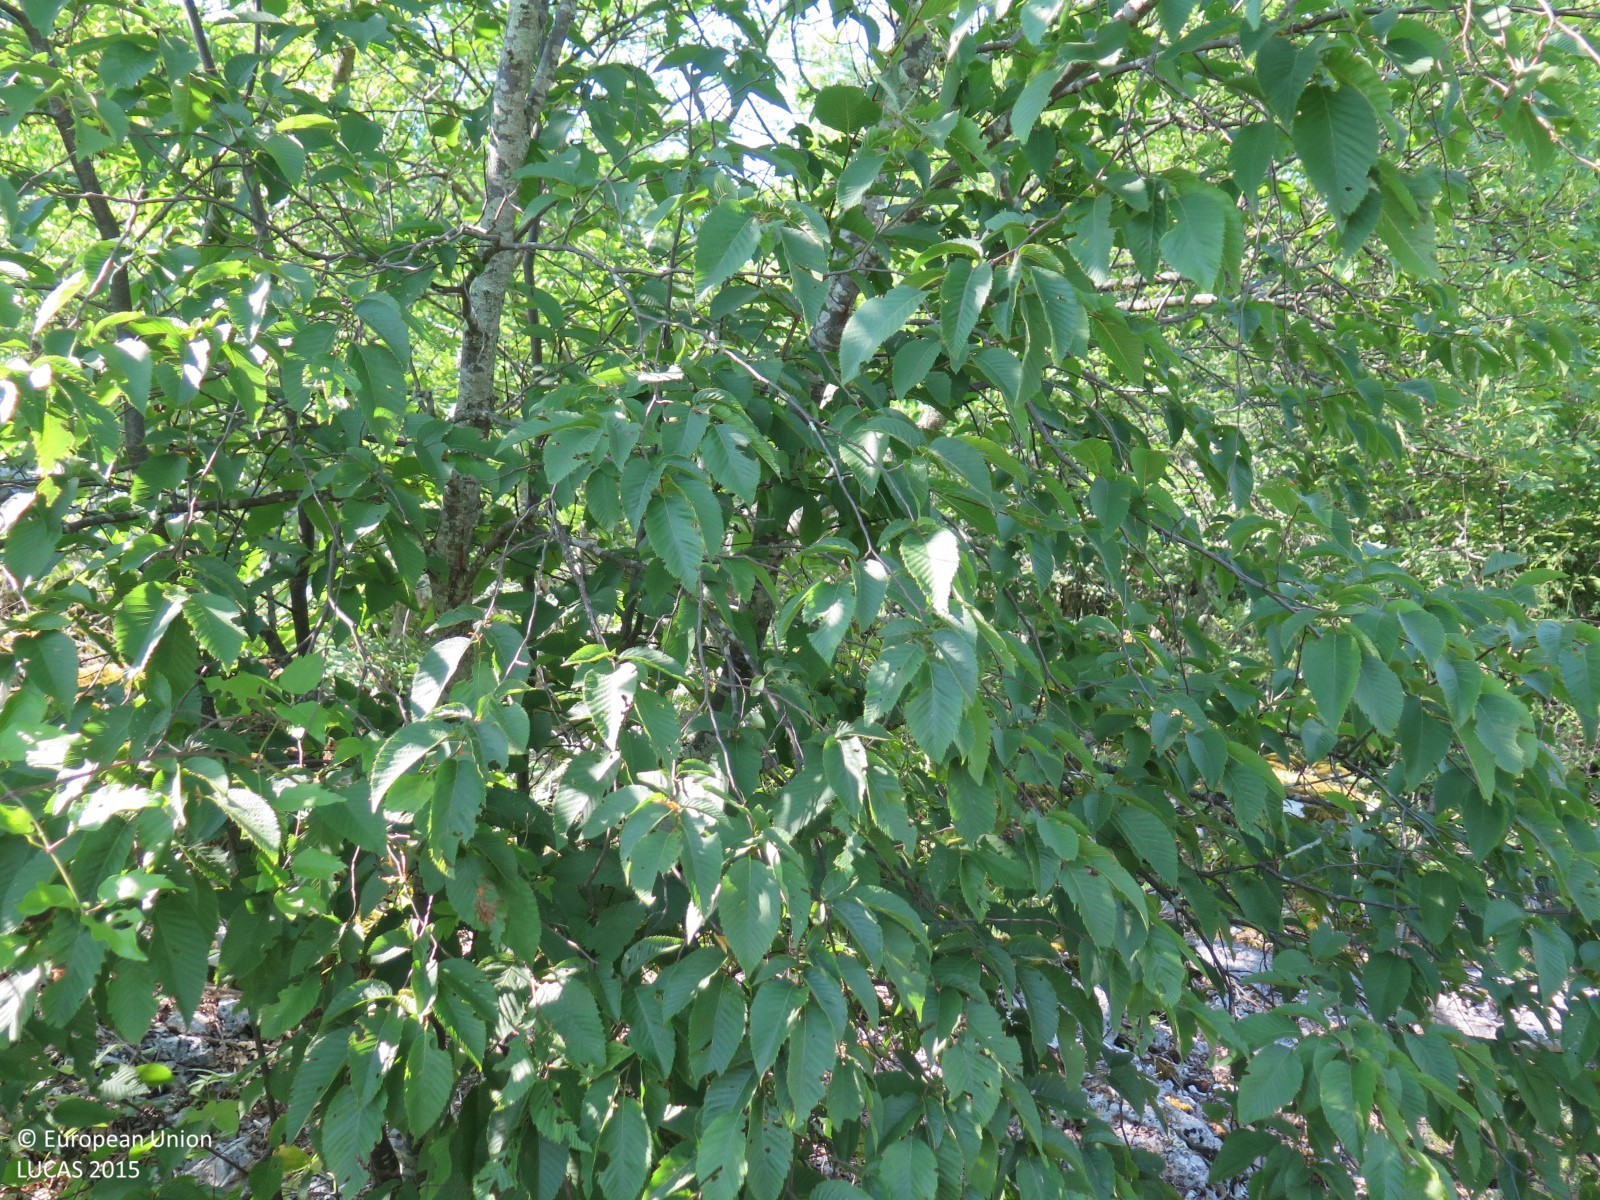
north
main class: Woodland
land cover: Broadleaved woodland
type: mesophytic deciduous forest
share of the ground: > 75 %
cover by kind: broadleaved forest trees 90 %, herbaceous plants 5 %, unconsolidated bare surface 5 %
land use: Semi-natural and natural areas not in use
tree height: > 5 m
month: July
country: HR
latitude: 45.2356
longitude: 13.8545
